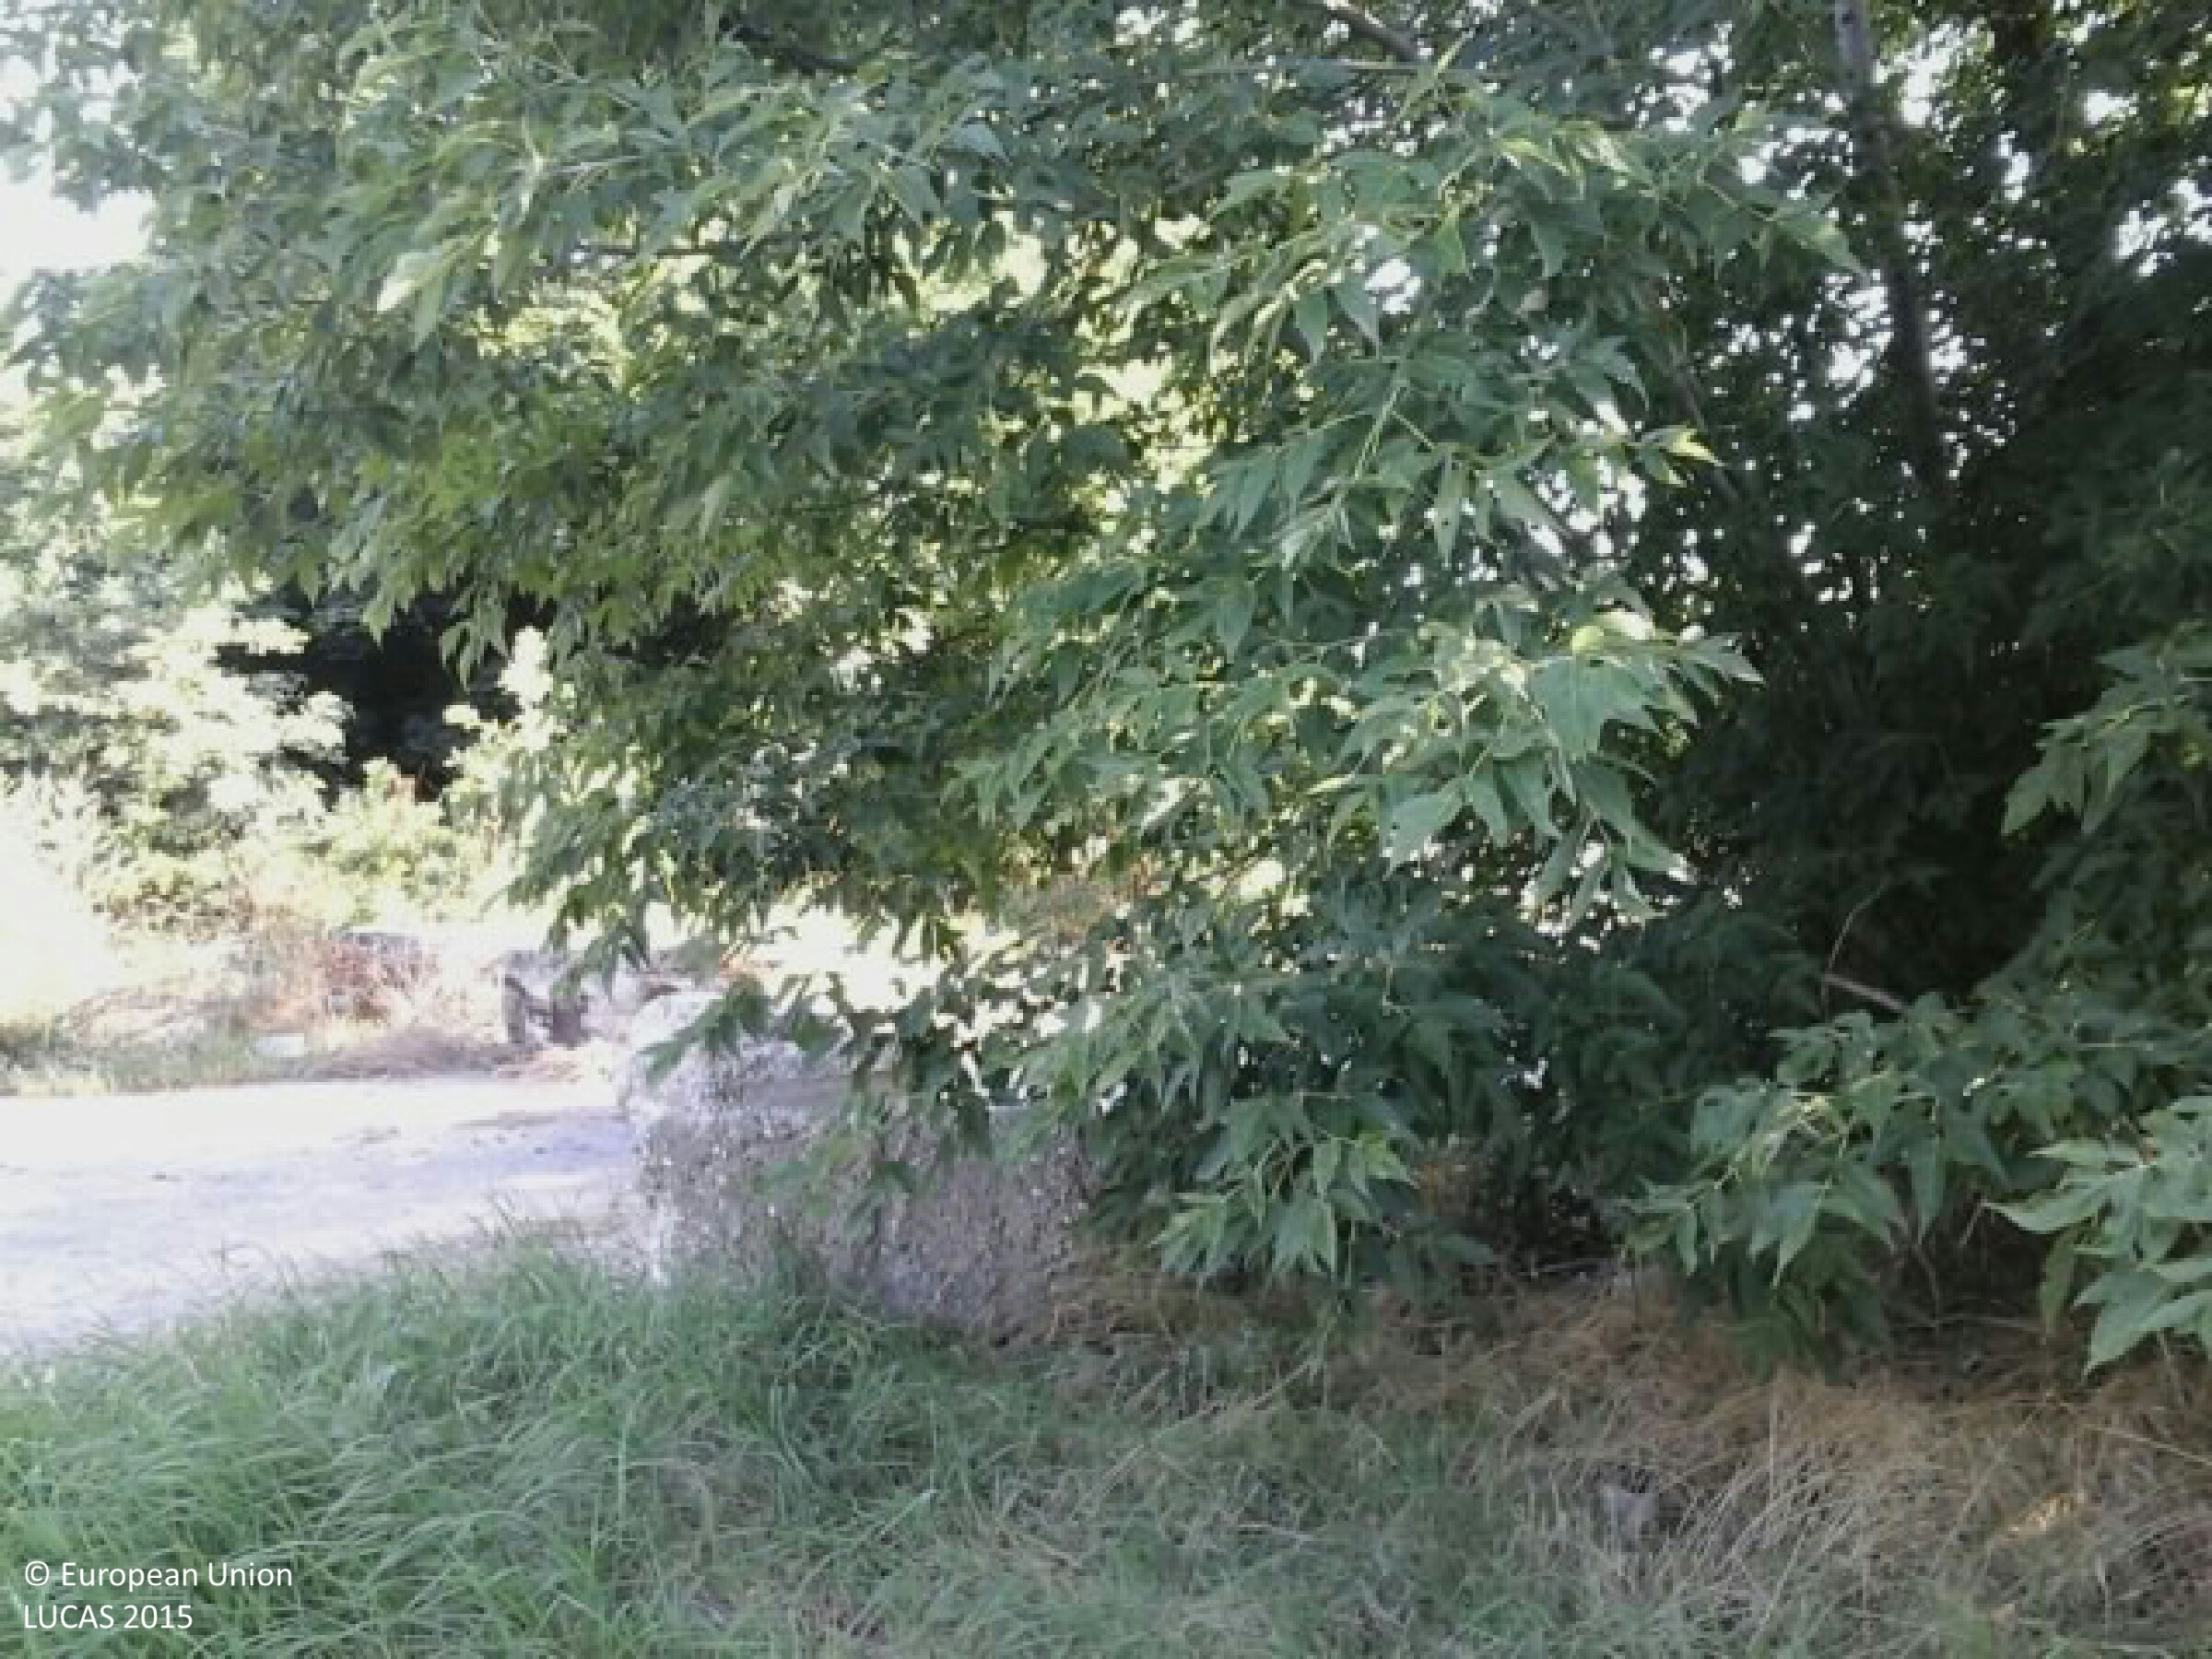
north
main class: Cropland
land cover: Maize
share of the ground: > 75 %
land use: Agriculture (excluding fallow land and kitchen gardens)
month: August
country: HU
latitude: 46.4918
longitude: 17.9151
